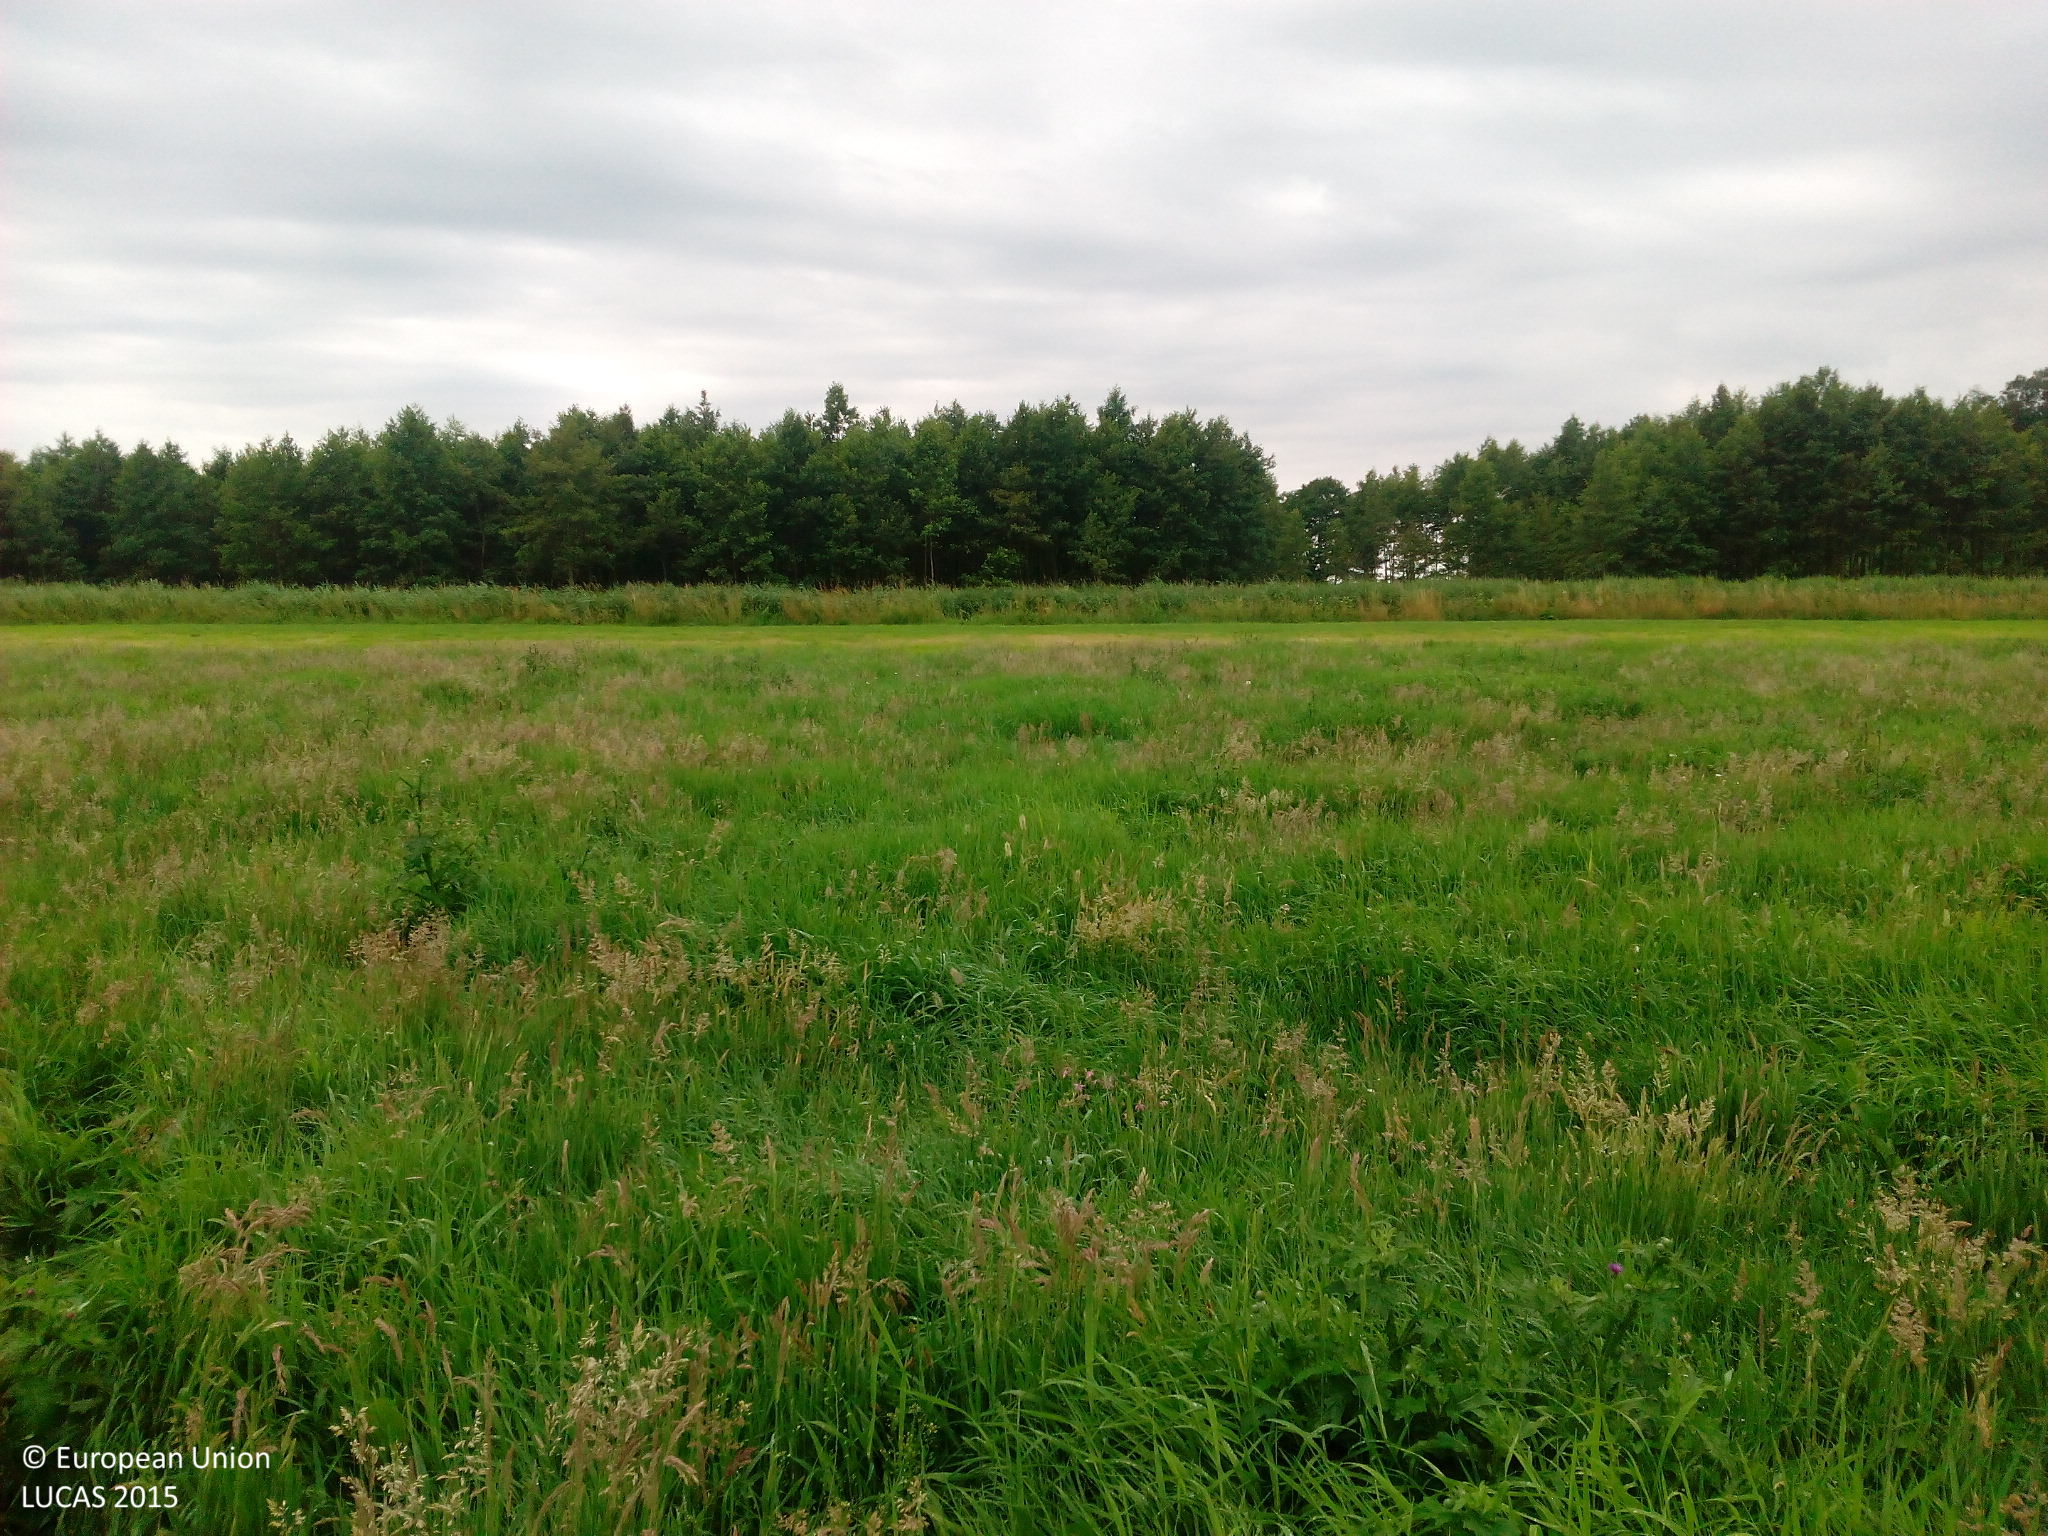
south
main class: Grassland
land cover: Grassland without tree/shrub cover
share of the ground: > 75 %
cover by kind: herbaceous plants 100 %
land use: Agriculture (excluding fallow land and kitchen gardens)
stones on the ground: < 10 %
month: July
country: DE
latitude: 53.5448
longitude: 14.2111
